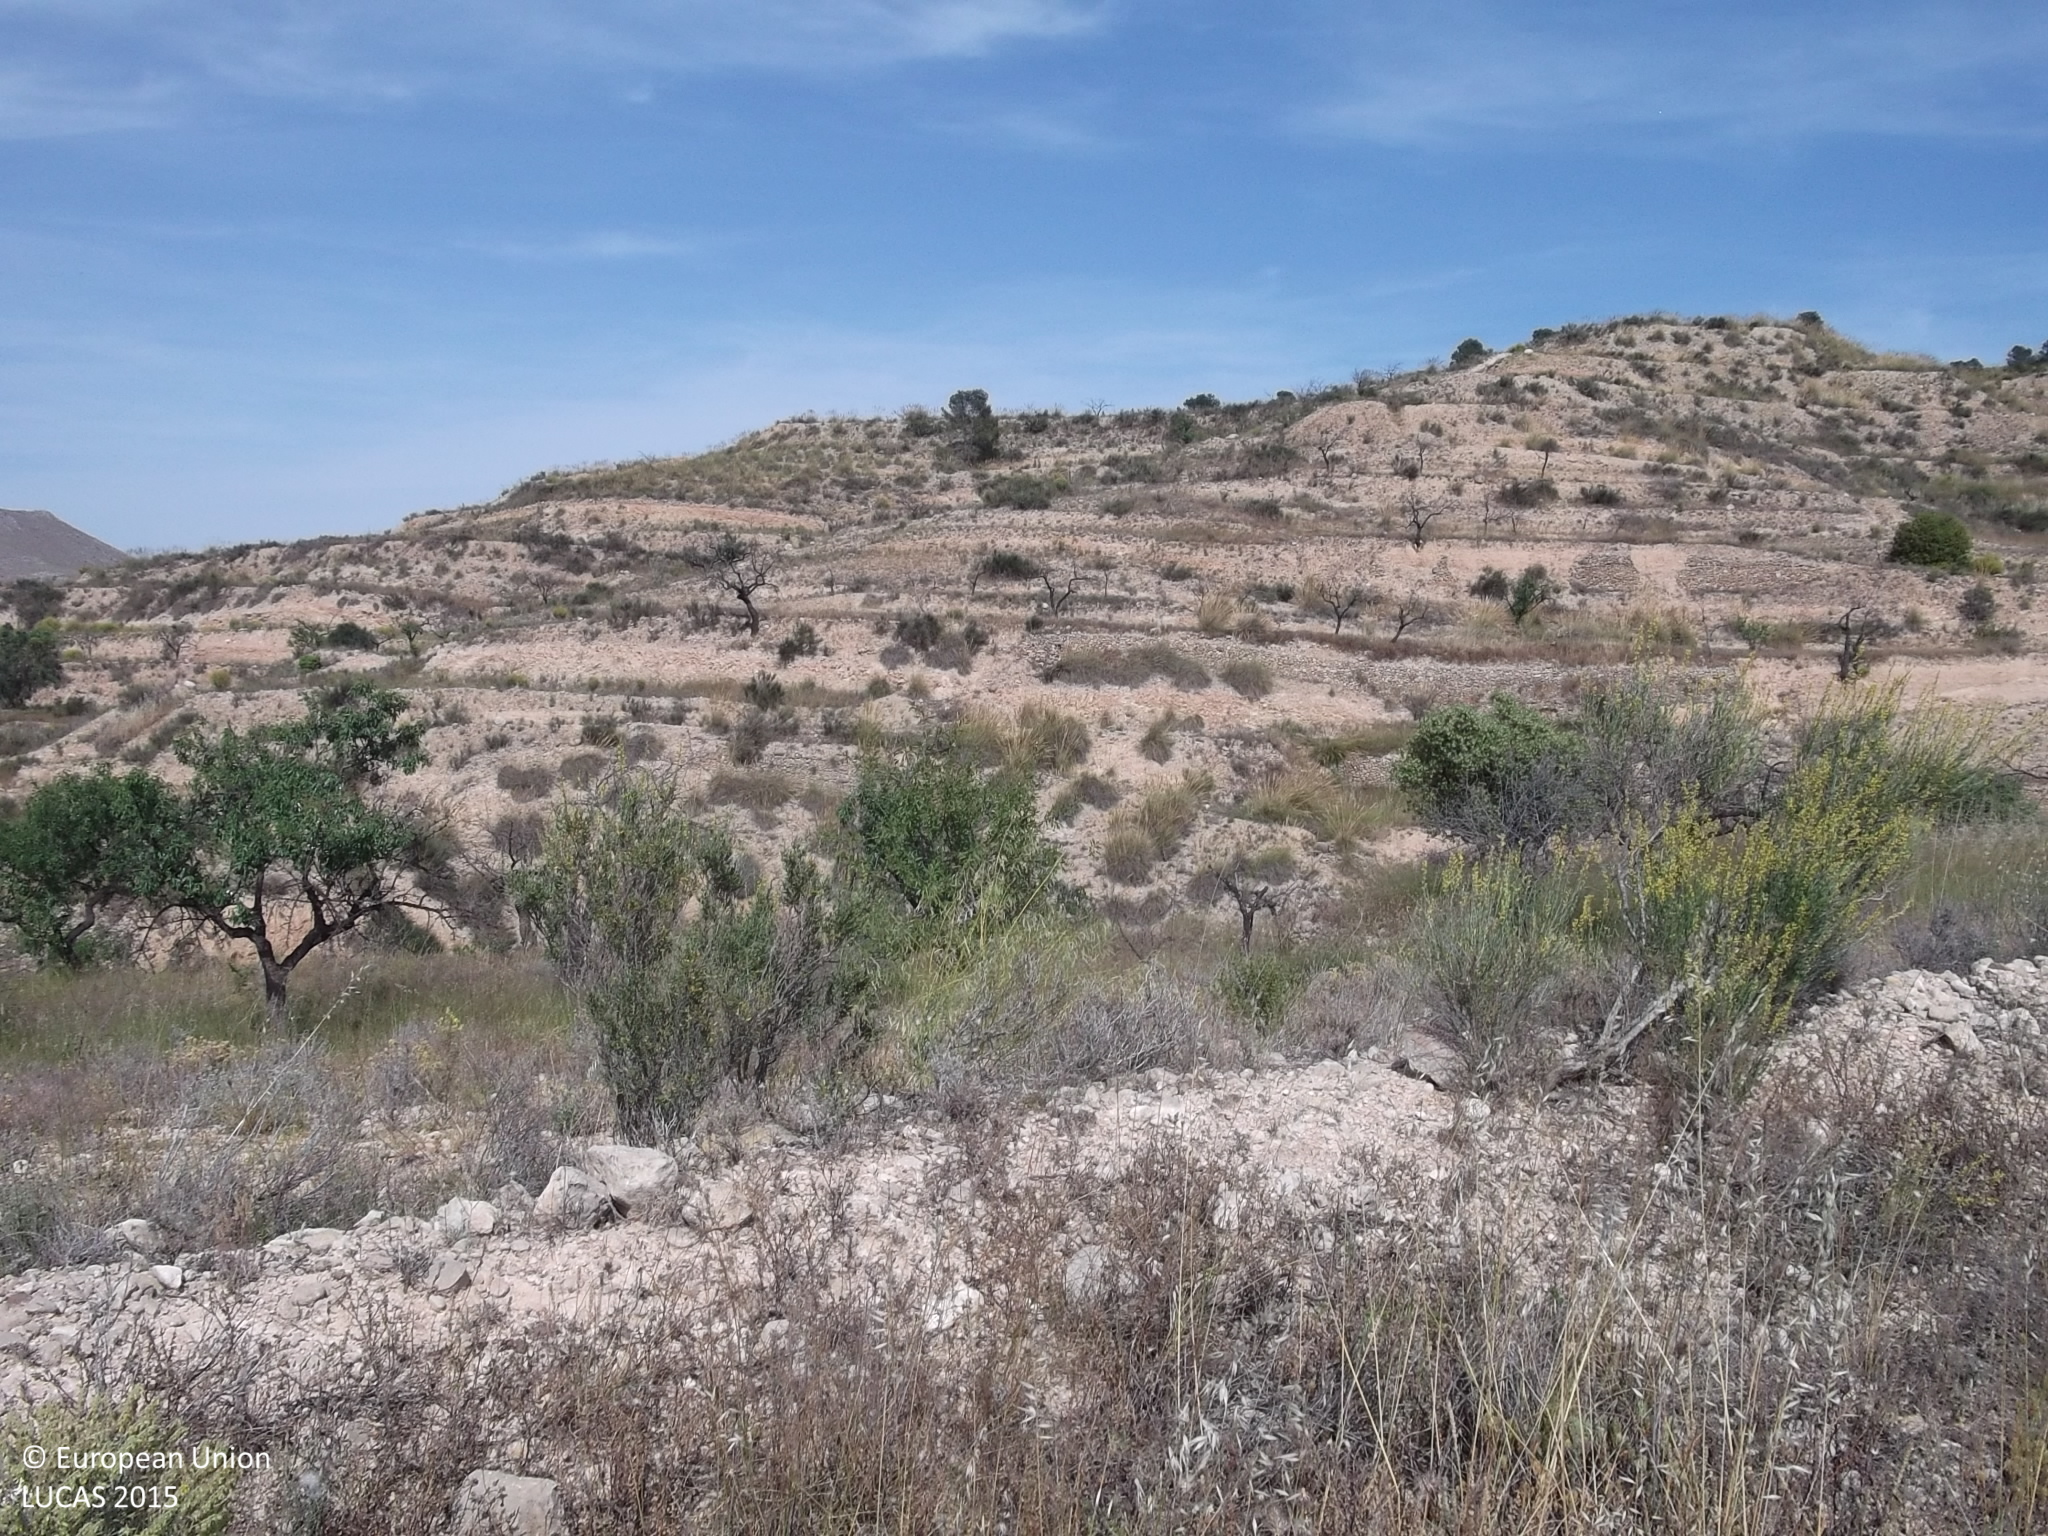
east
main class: Shrubland
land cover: Shrubland without tree cover
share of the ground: 10 - 25 %
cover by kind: consolidated bare surface 50 %, herbaceous plants 30 %, shrubs 20 %
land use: Abandoned areas
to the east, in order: Shrubland without tree cover; Grass margins; Nuts trees; Grass margins; Nuts trees; Shrubland without tree cover; Tracks; Shrubland without tree cover; Nuts trees; Shrubland without tree cover; Tracks; Shrubland with sparse tree cover
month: May
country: ES
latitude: 38.2600
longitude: -0.9922
